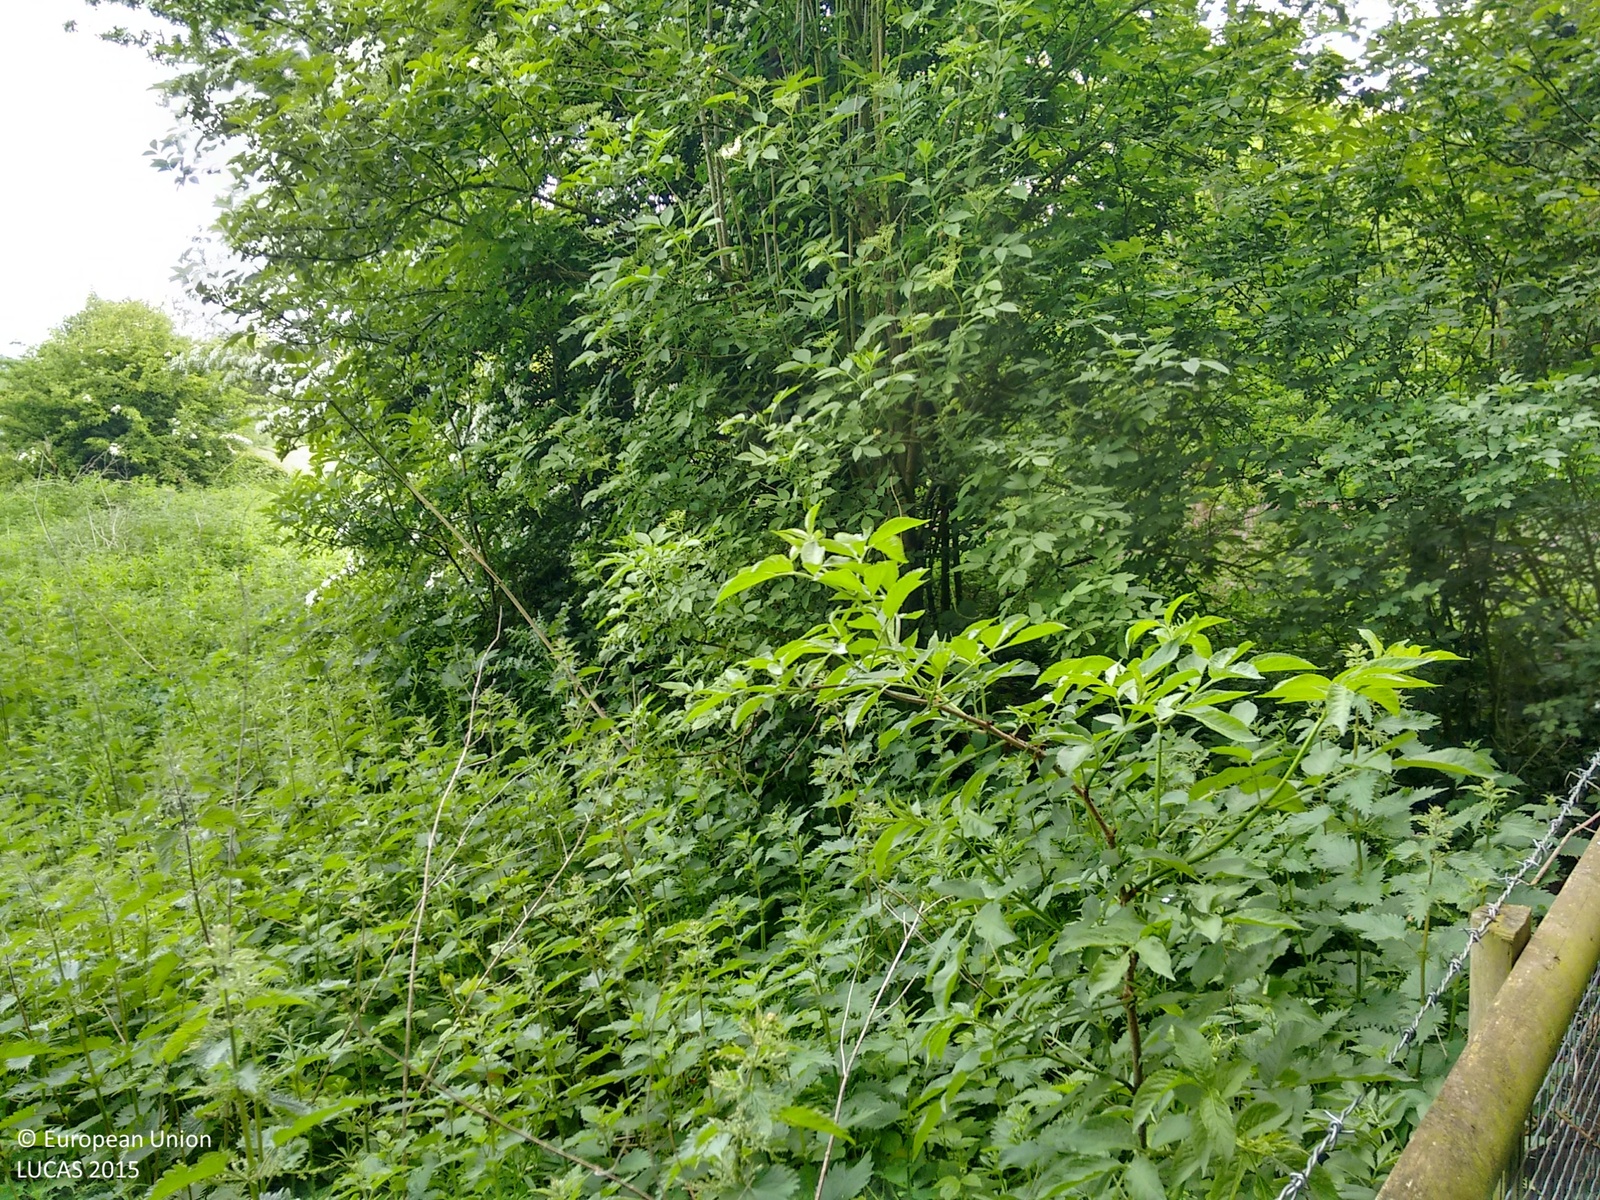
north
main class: Grassland
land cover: Spontaneously vegetated surfaces
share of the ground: > 75 %
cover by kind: herbaceous plants 95 %, shrubs 5 %
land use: Semi-natural and natural areas not in use
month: May
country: GB
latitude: 51.1983
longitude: 1.1768
